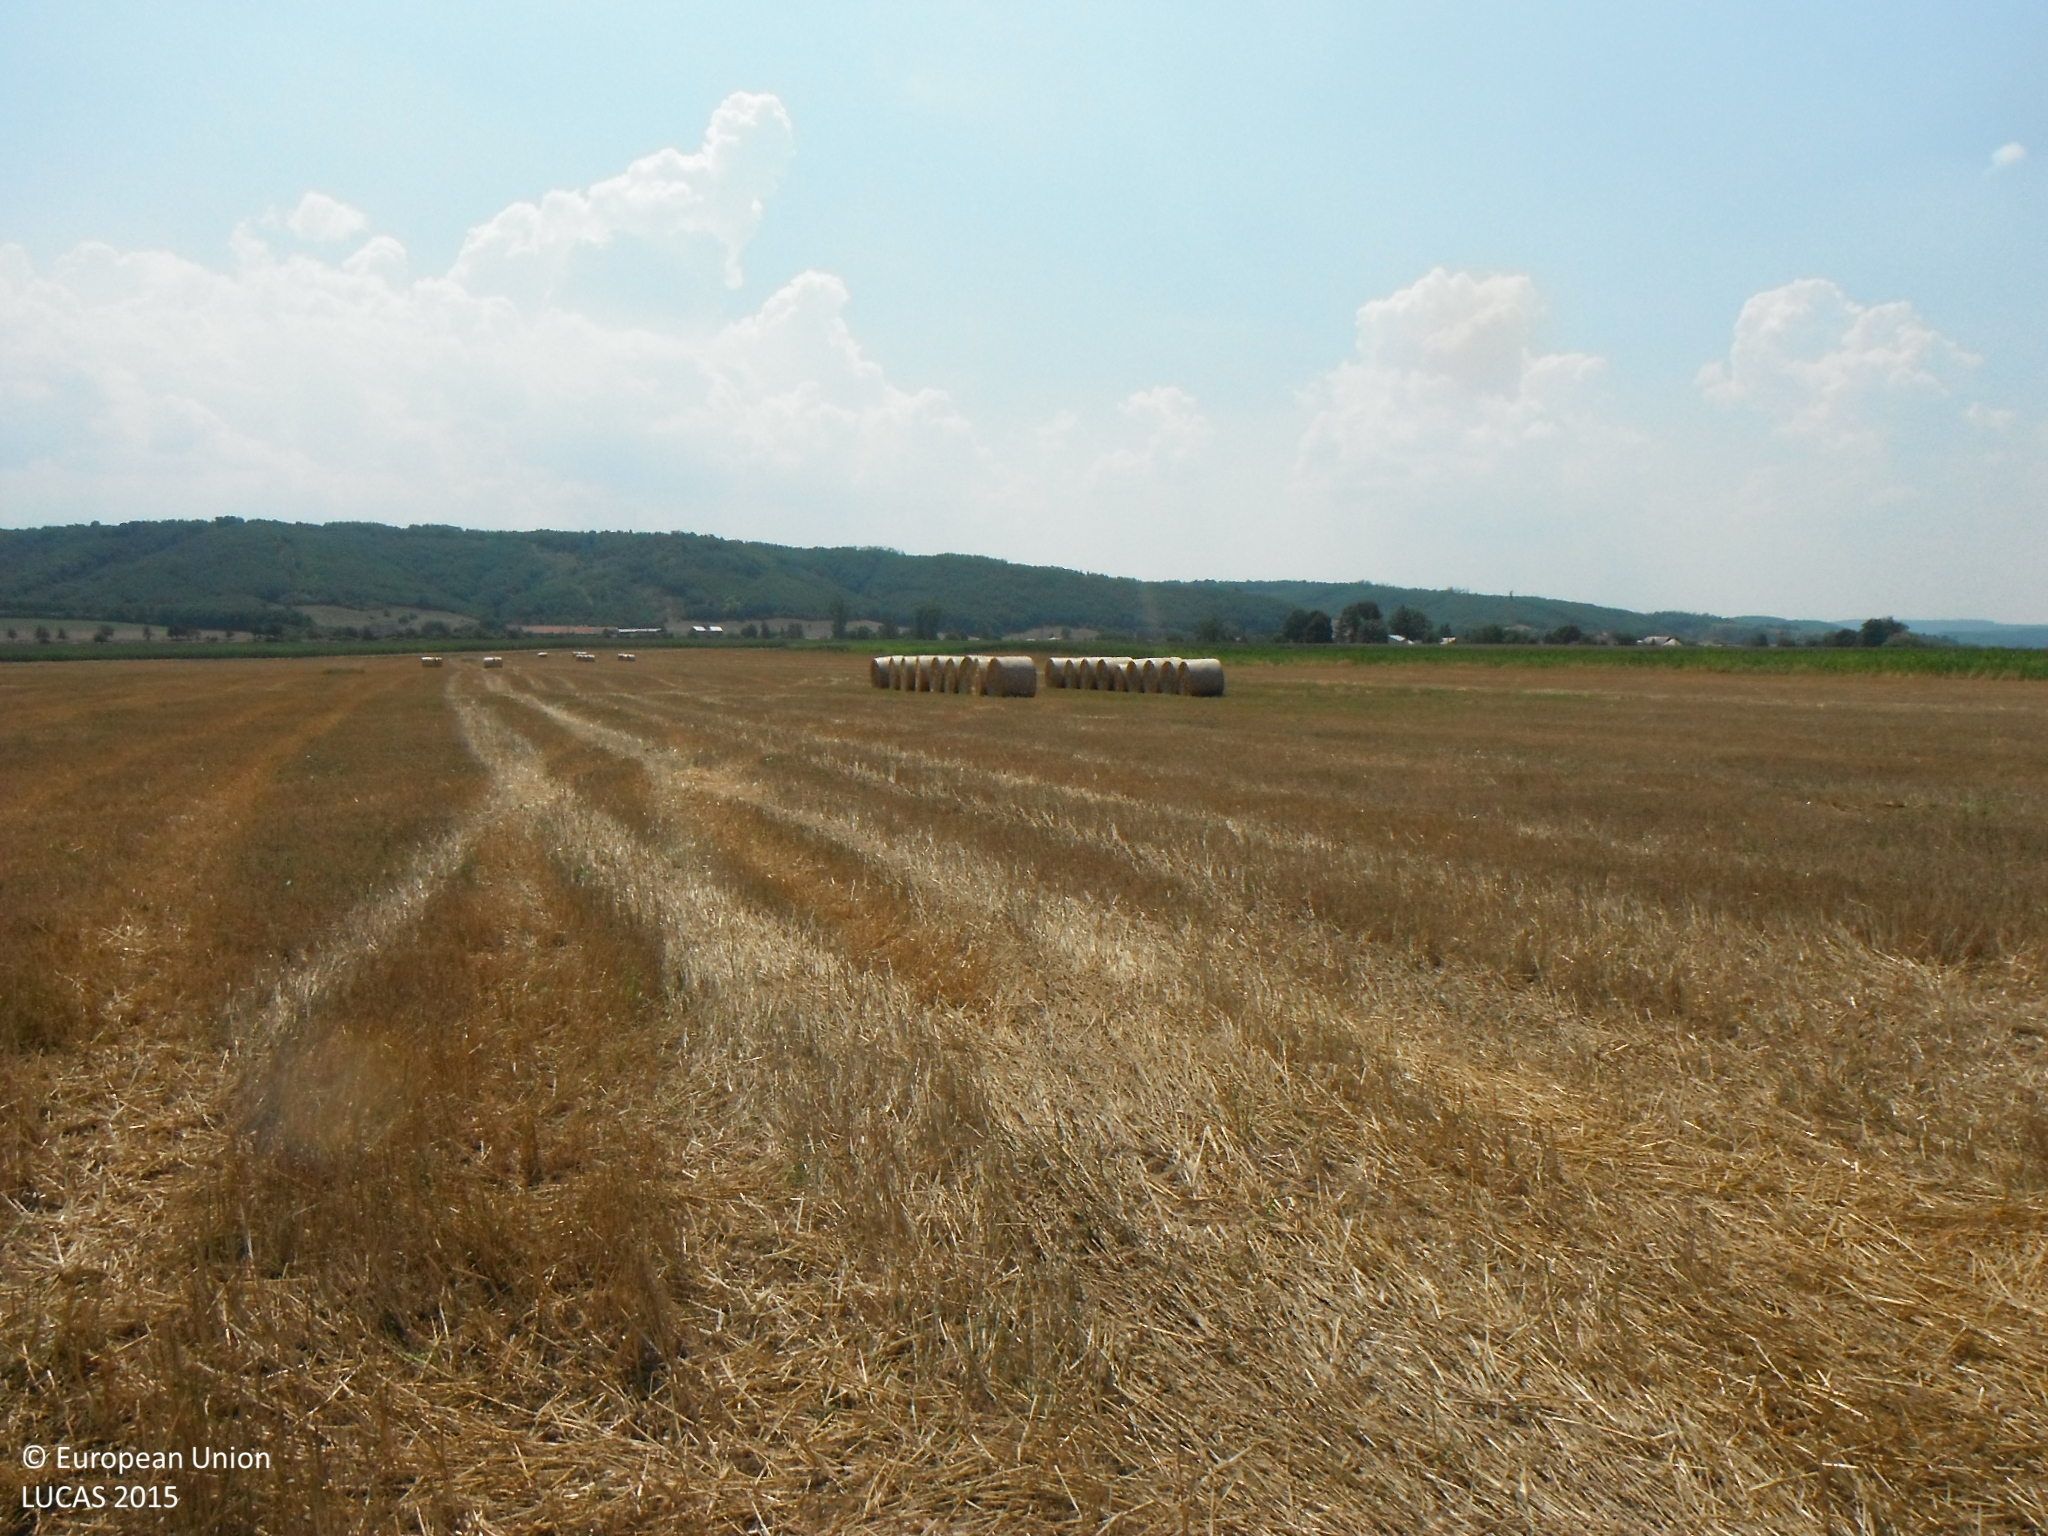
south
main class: Cropland
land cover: Common wheat
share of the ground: > 75 %
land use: Agriculture (excluding fallow land and kitchen gardens)
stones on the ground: < 10 %
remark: Harvested field
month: July
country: SK
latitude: 48.2696
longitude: 19.6587
